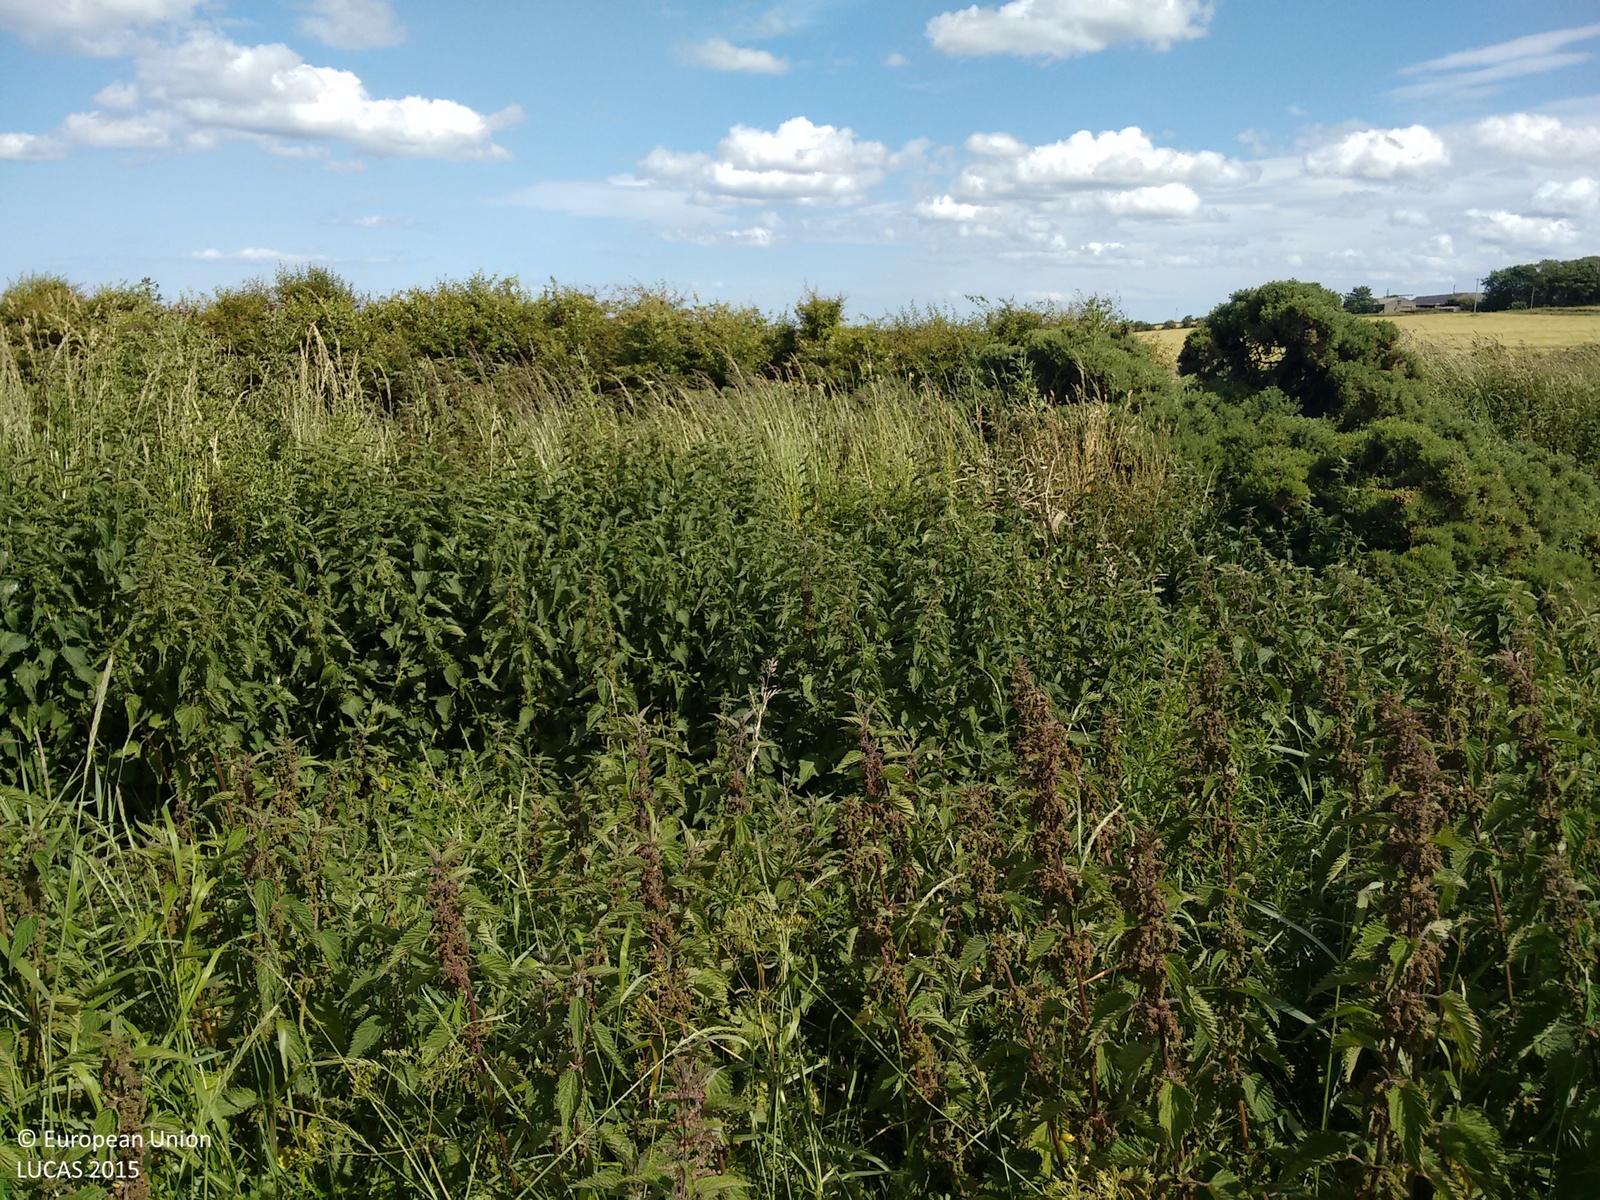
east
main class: Cropland
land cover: Rape and turnip rape
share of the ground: > 75 %
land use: Agriculture (excluding fallow land and kitchen gardens)
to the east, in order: Rape and turnip rape; Spontaneously vegetated surfaces; Ditches and canals; Shrubland without tree cover; Electric lines; Fences; Shrubland without tree cover; Managed hedges; Fences; Spontaneously vegetated surfaces; Grass margins; Barley; Spontaneously vegetated surfaces; Ditches and canals; Grass margins; Barley
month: July
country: GB
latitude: 57.6527
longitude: -2.0942
